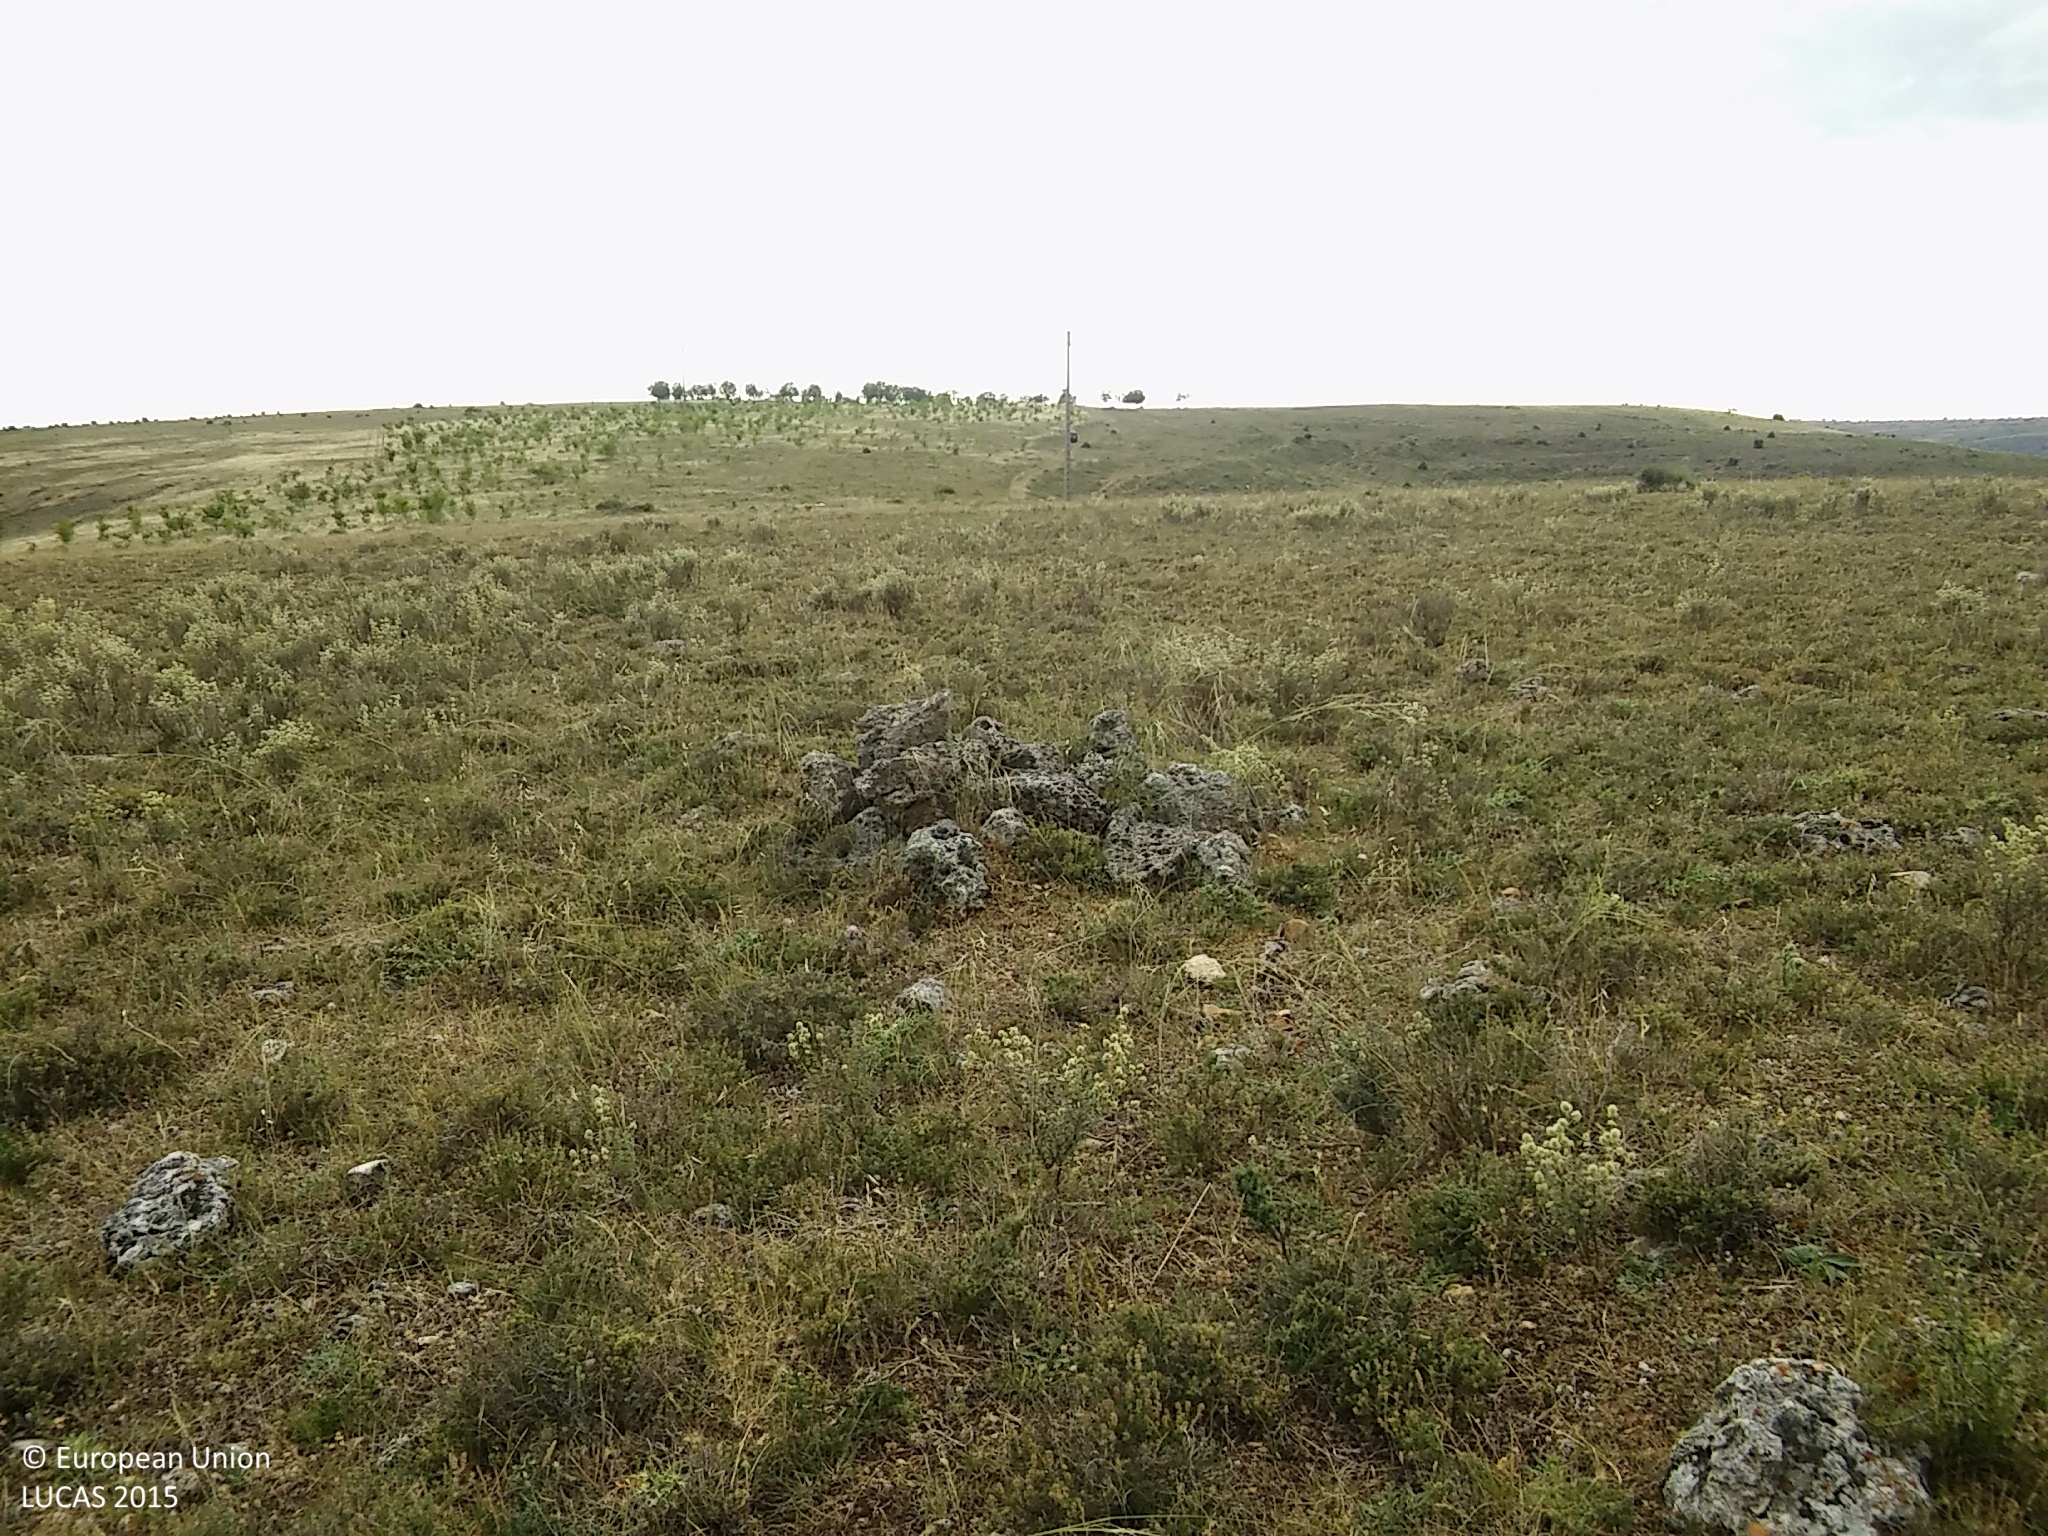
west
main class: Shrubland
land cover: Shrubland without tree cover
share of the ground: 25 - 50 %
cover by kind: shrubs 40 %, lichens and mosses 30 %, unconsolidated bare surface 20 %, herbaceous plants 10 %
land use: Semi-natural and natural areas not in use
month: June
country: ES
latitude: 41.2943
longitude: -3.7221
